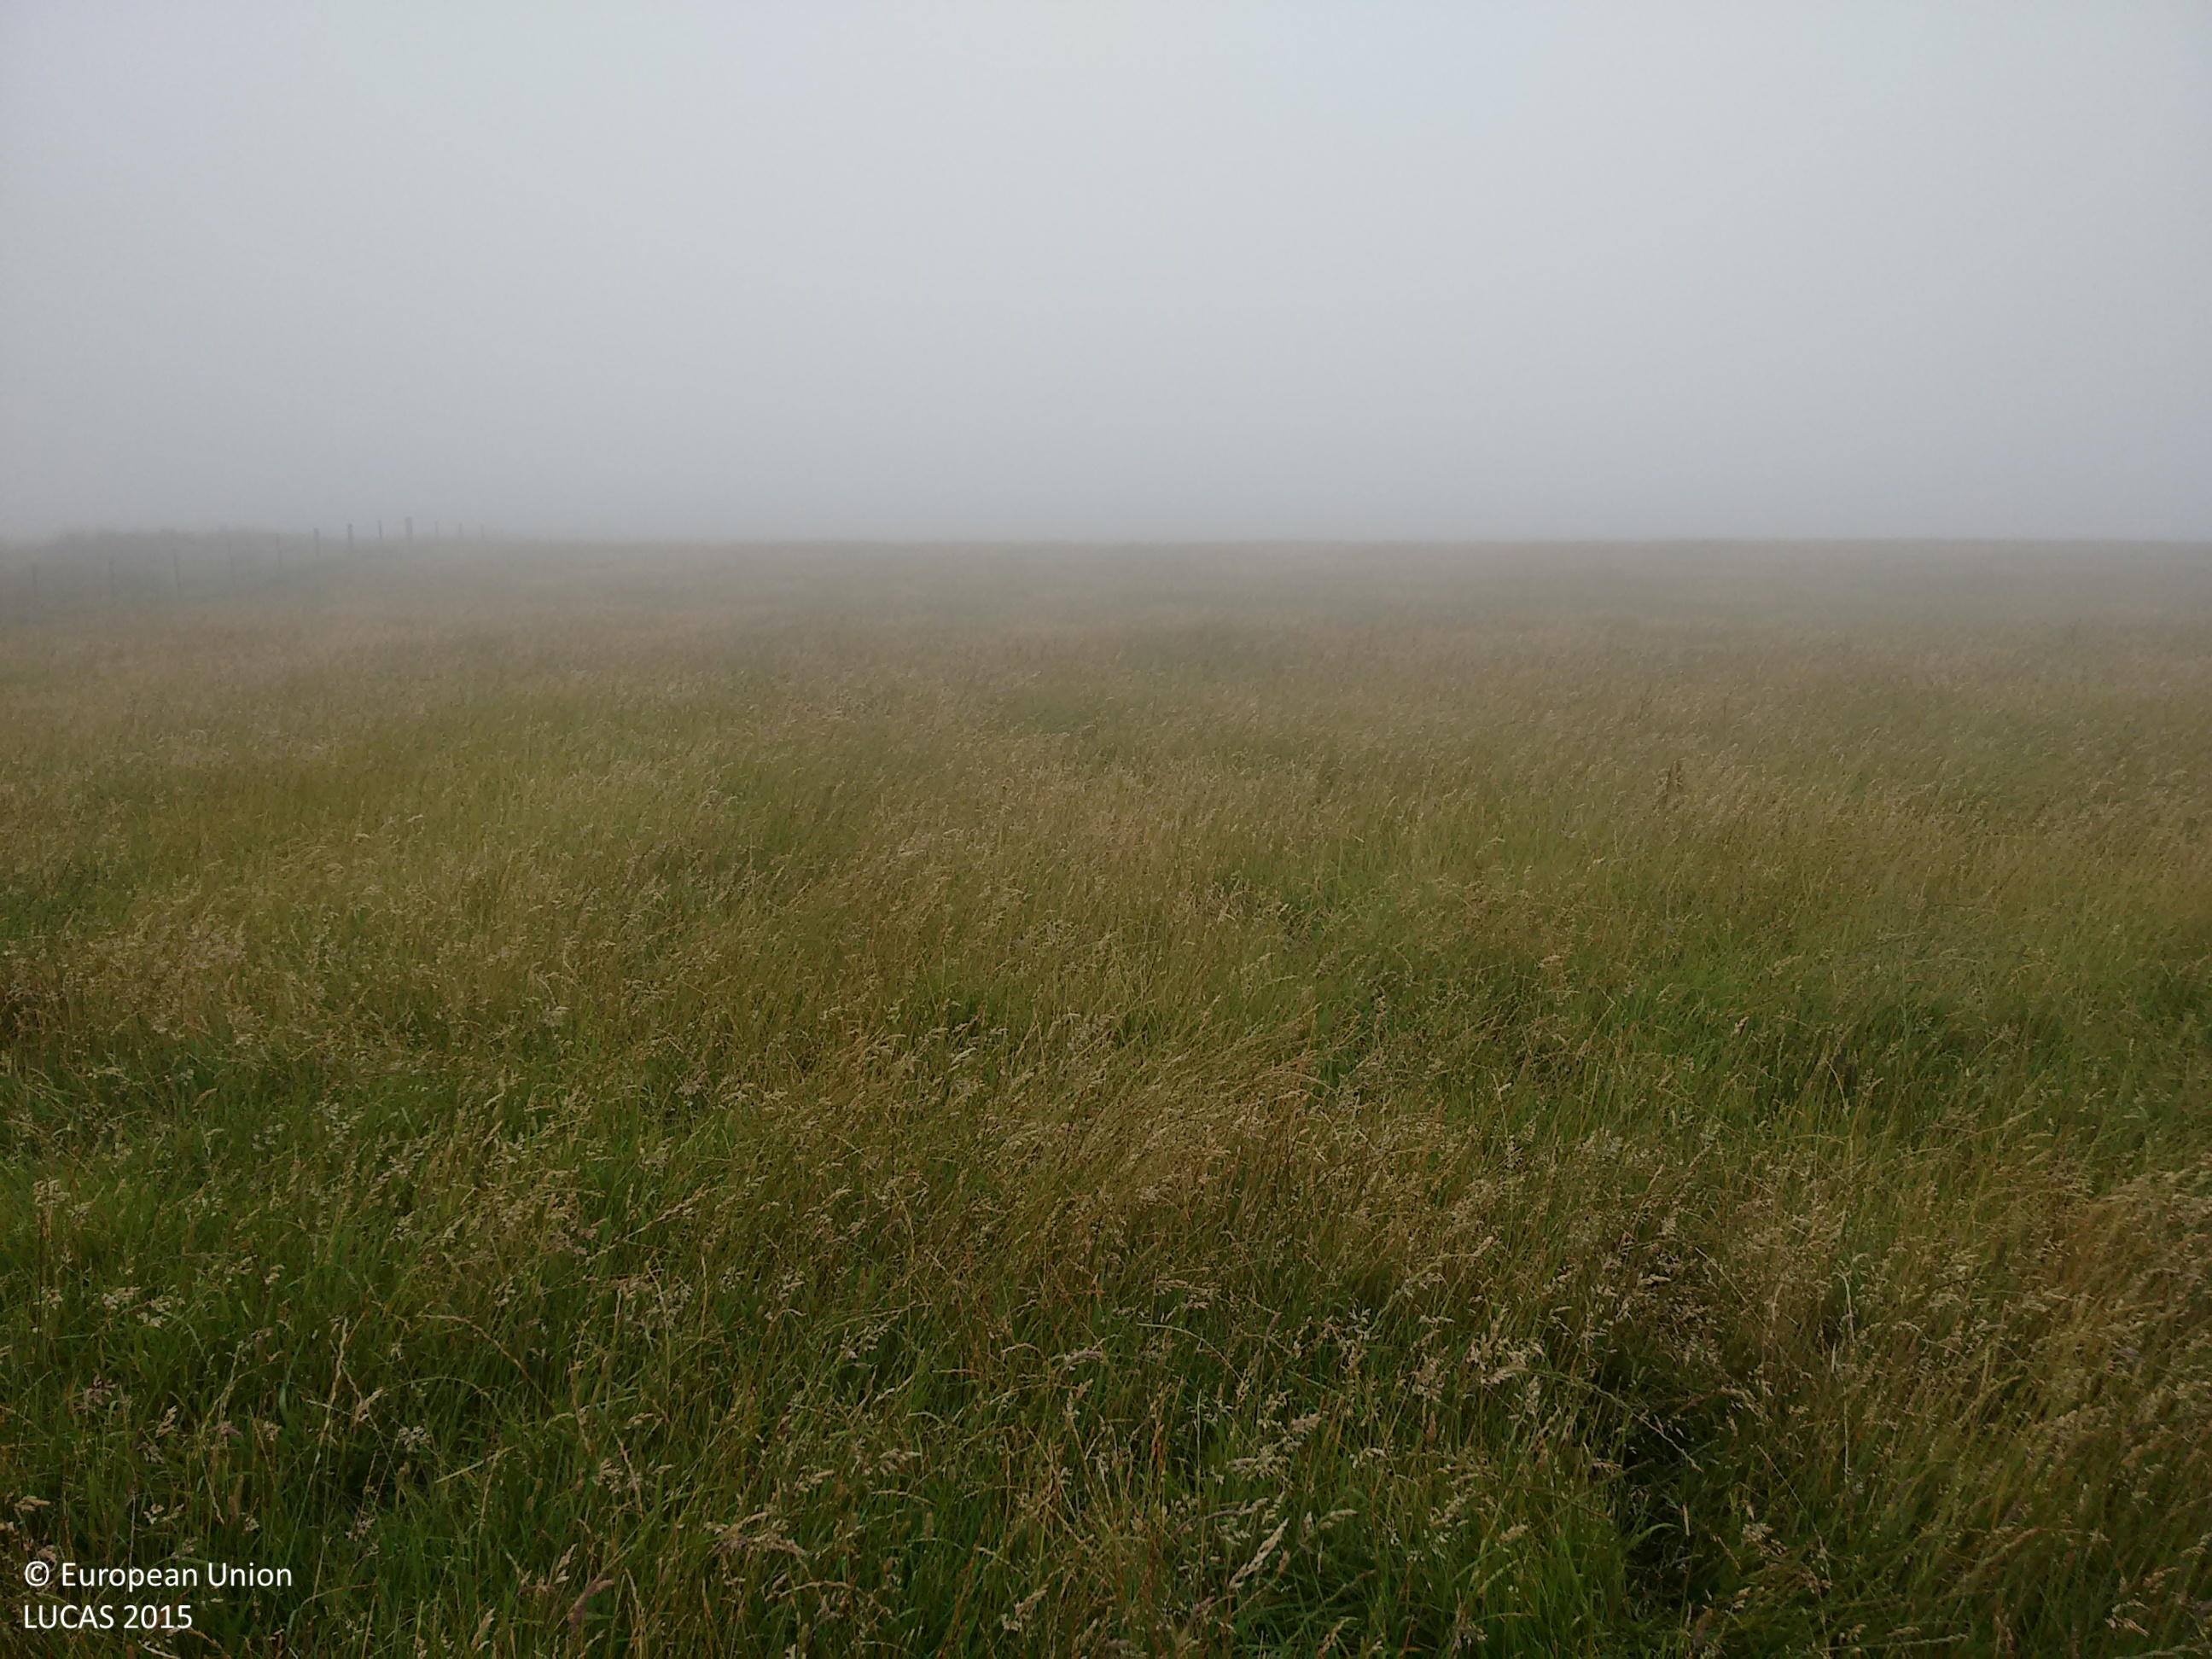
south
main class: Grassland
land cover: Grassland without tree/shrub cover
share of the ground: > 75 %
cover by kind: herbaceous plants 100 %
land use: Agriculture (excluding fallow land and kitchen gardens)
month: August
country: GB
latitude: 51.1467
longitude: -3.7991
